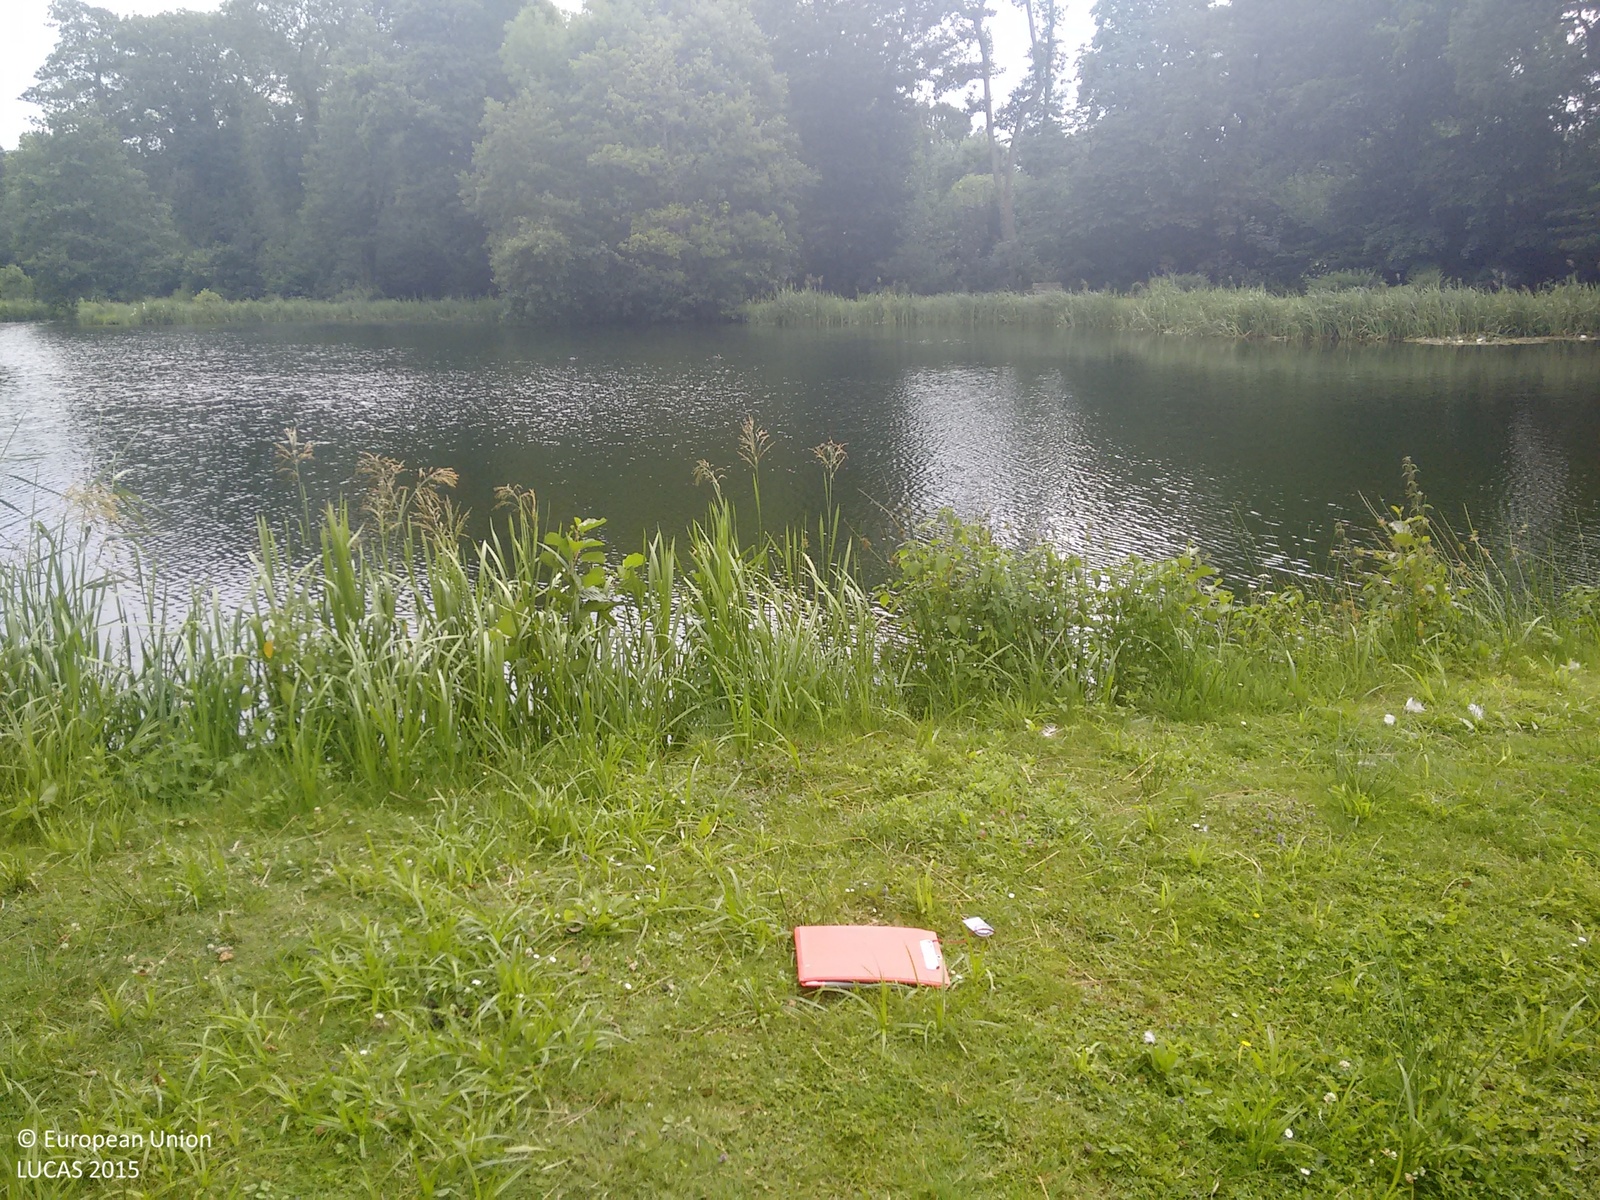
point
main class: Grassland
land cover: Grassland without tree/shrub cover
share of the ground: > 75 %
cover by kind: herbaceous plants 80 %, unconsolidated bare surface 20 %
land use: Sport
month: July
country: GB
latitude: 51.2184
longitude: -0.5333
